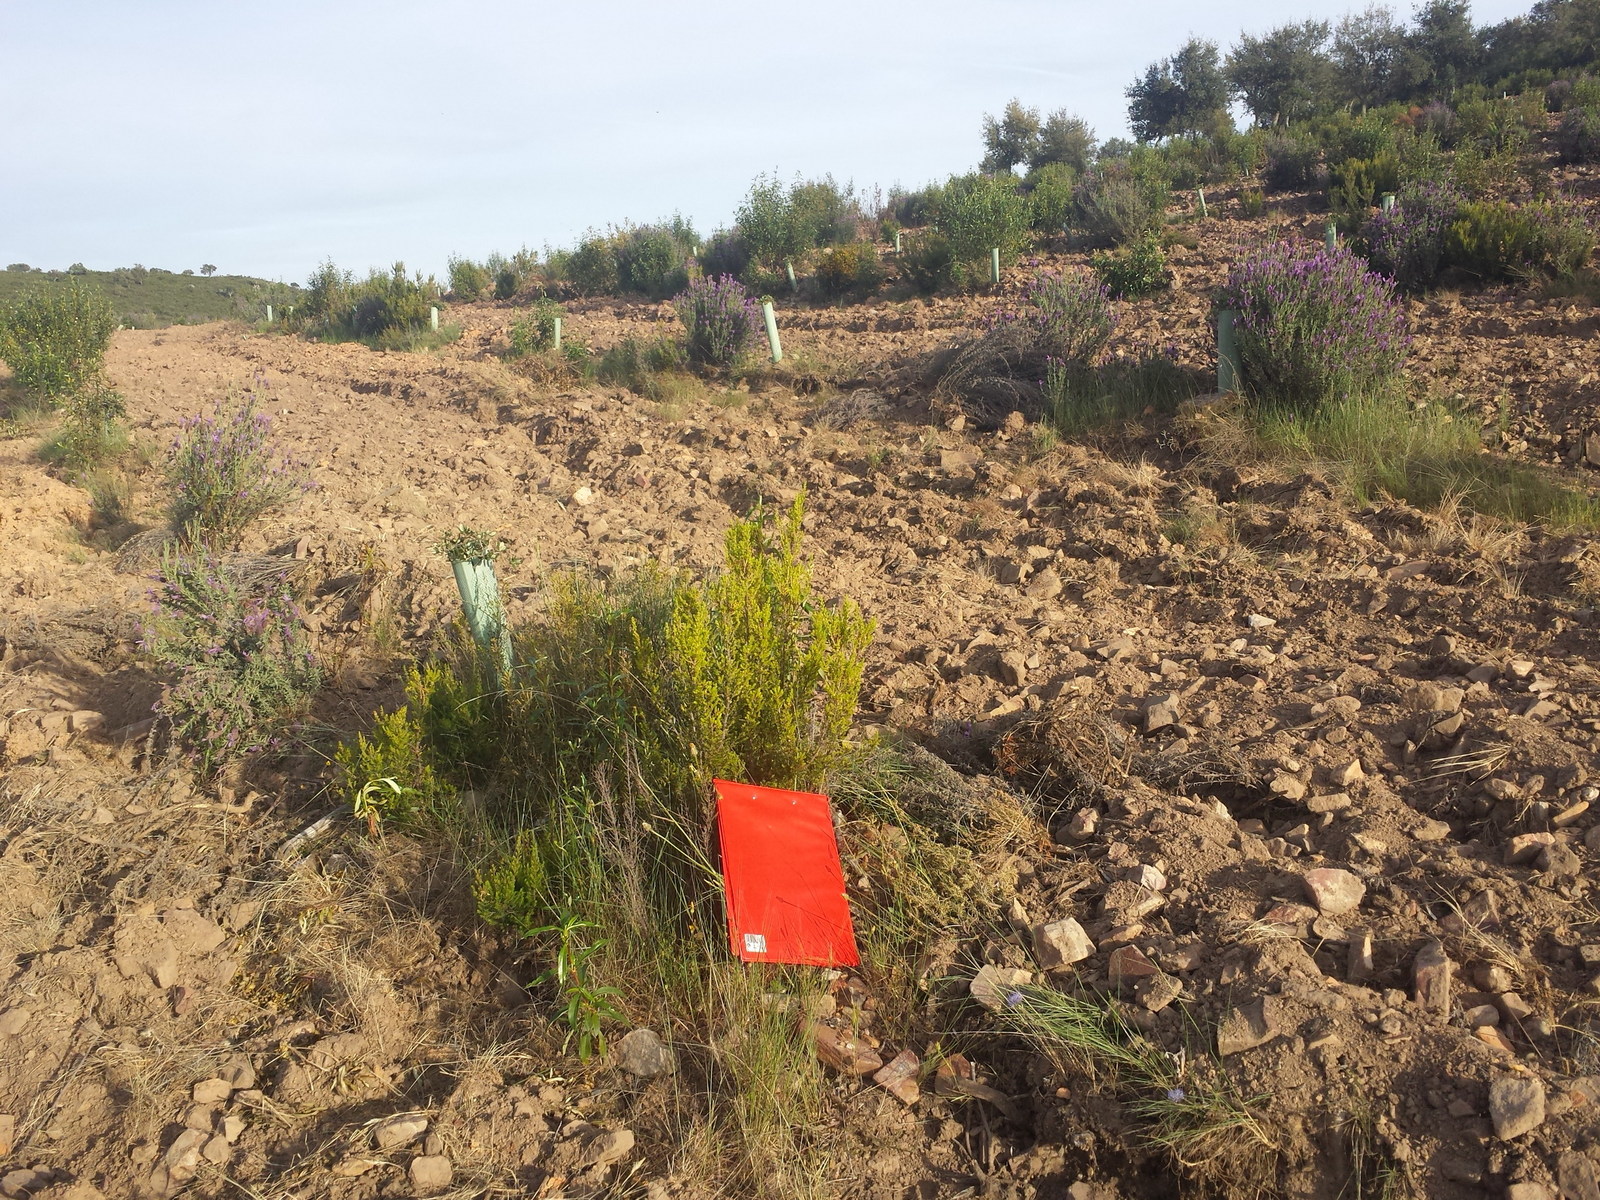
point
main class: Shrubland
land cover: Shrubland without tree cover
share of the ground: 10 - 25 %
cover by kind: unconsolidated bare surface 70 %, shrubs 15 %, herbaceous plants 15 %
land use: Forestry
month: May
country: ES
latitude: 39.5856
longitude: -7.1915
